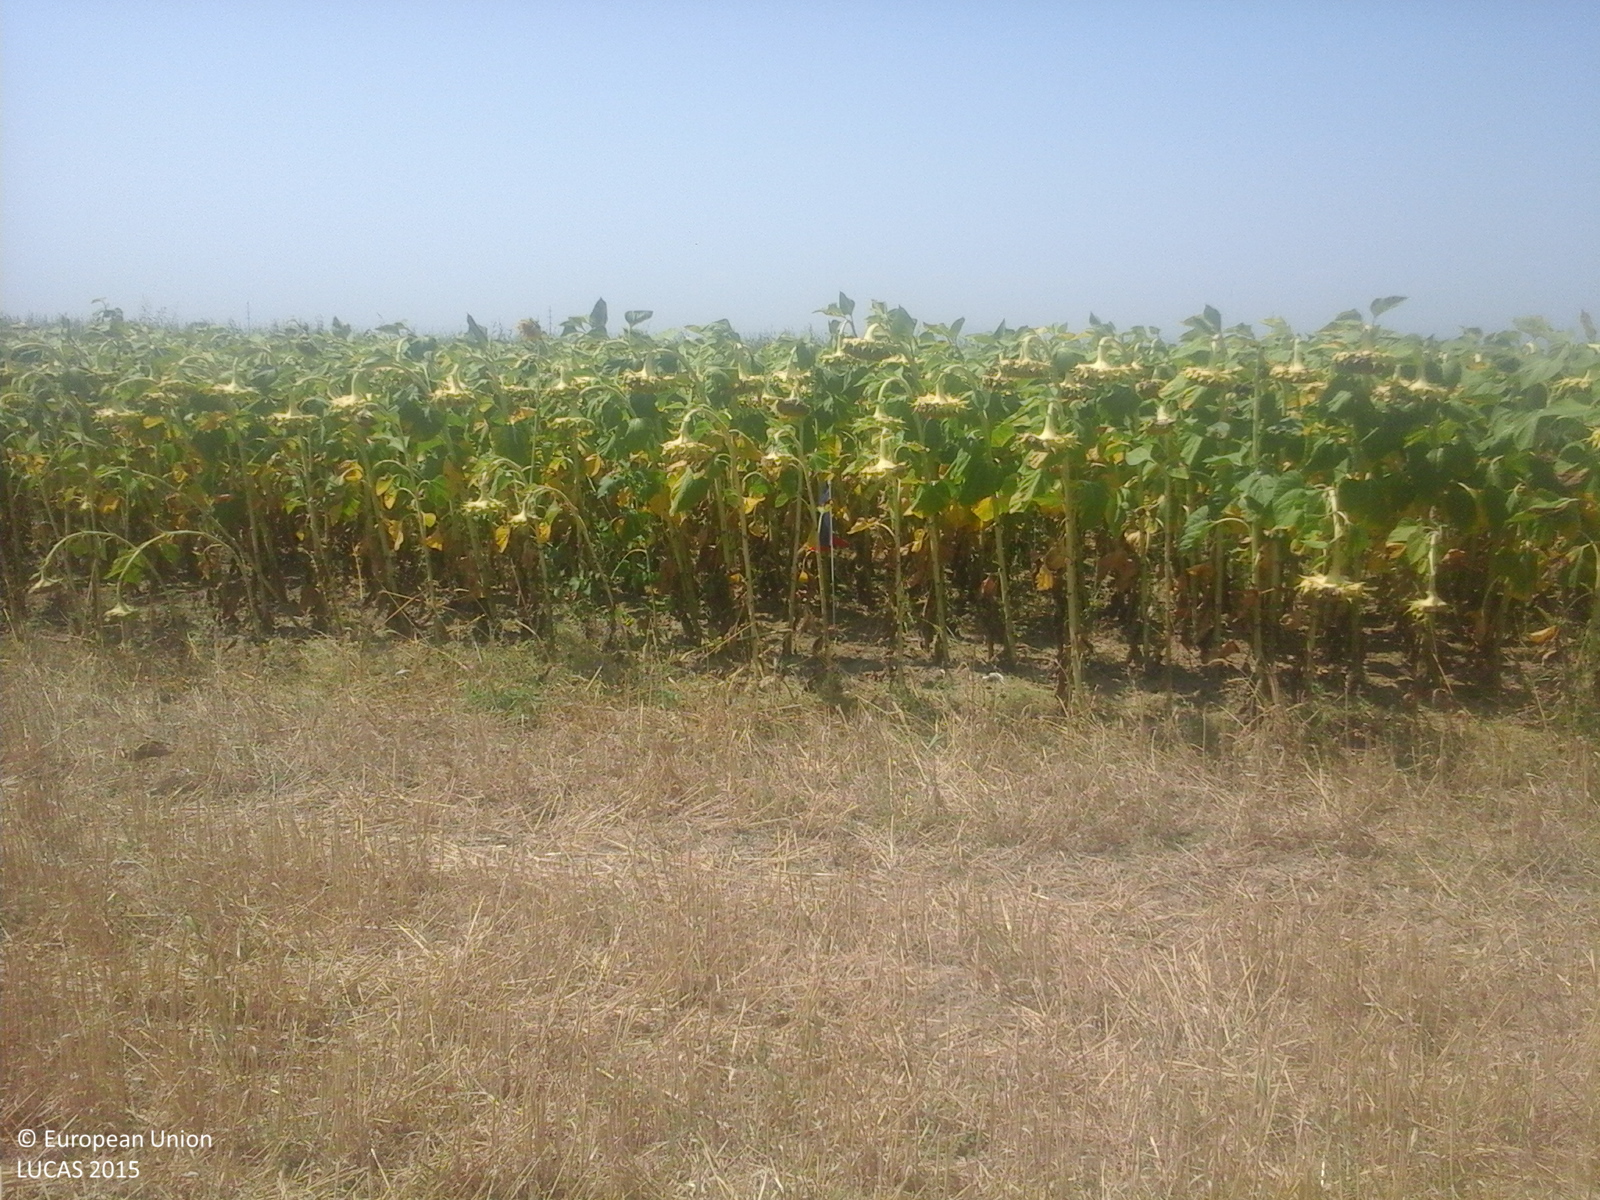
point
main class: Cropland
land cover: Sunflower
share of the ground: > 75 %
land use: Agriculture (excluding fallow land and kitchen gardens)
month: August
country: RO
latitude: 45.5451
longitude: 27.3505
